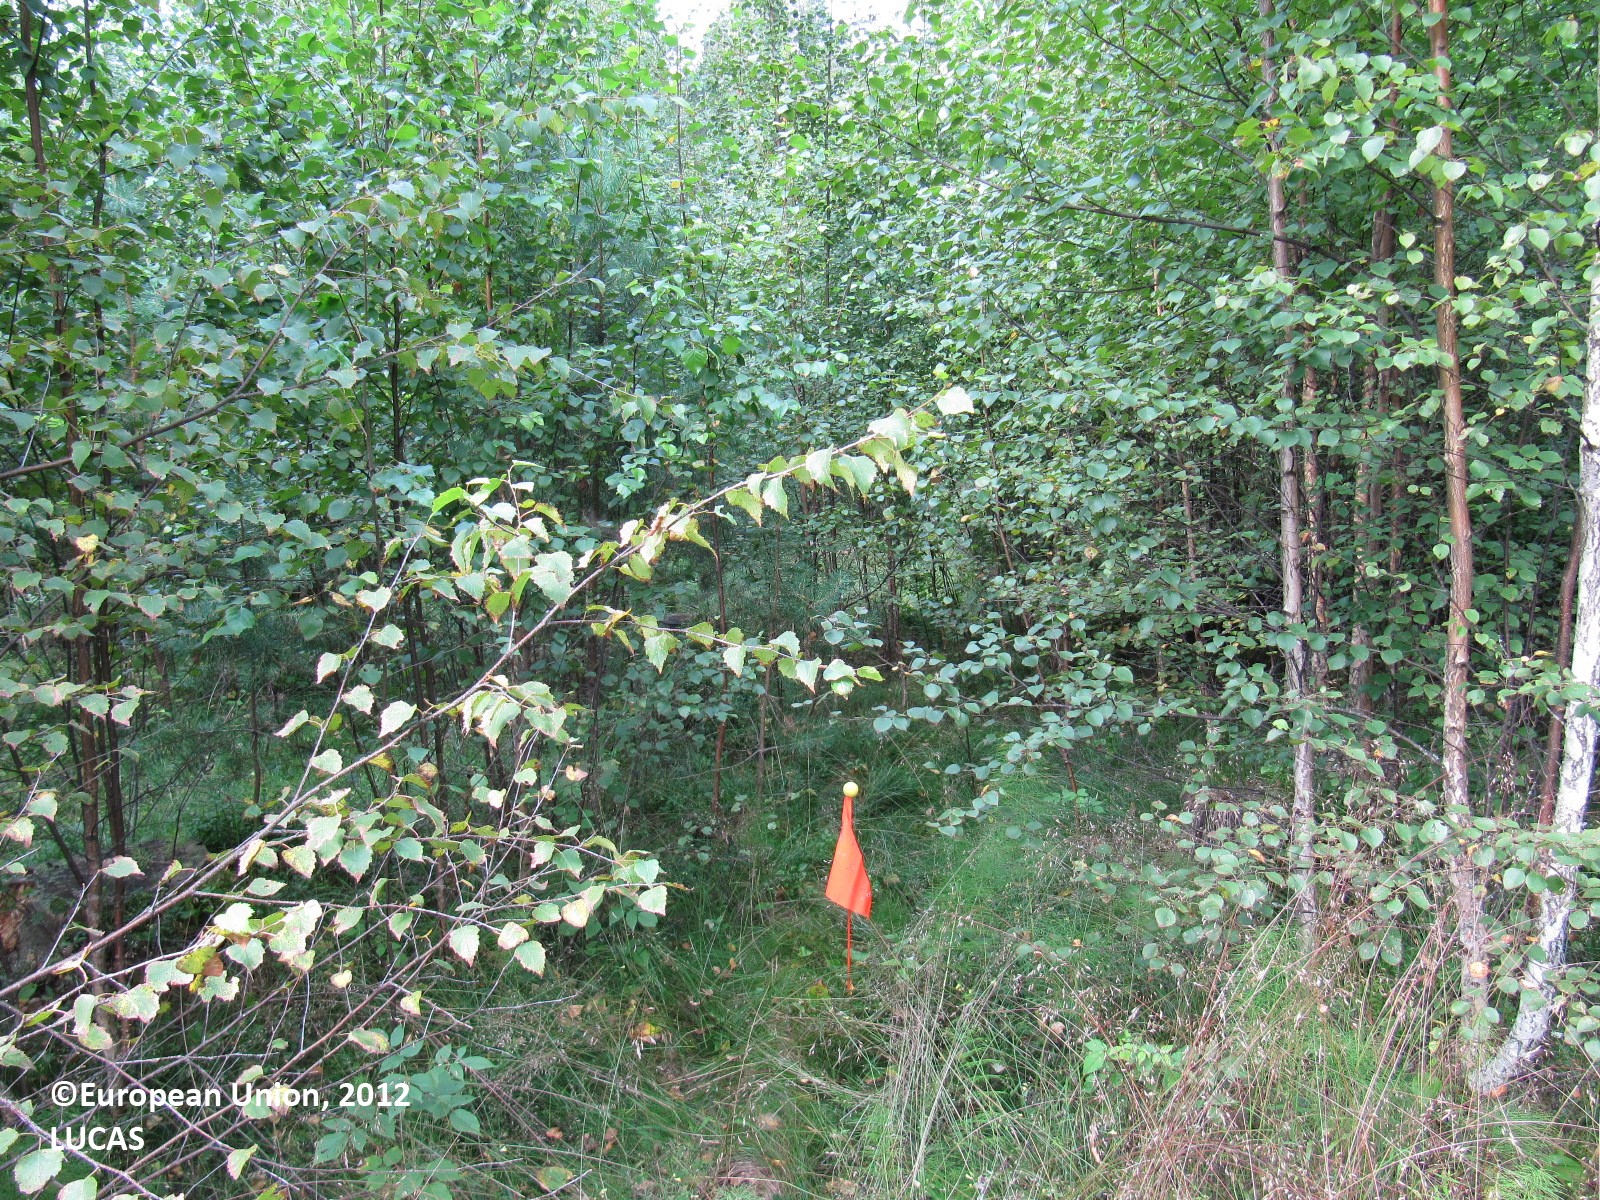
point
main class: Woodland
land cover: Other mixed woodland
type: boreal forest
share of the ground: 50 - 75 %
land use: Forestry
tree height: < 5 m
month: August
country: FI
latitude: 60.4684
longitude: 23.2320
